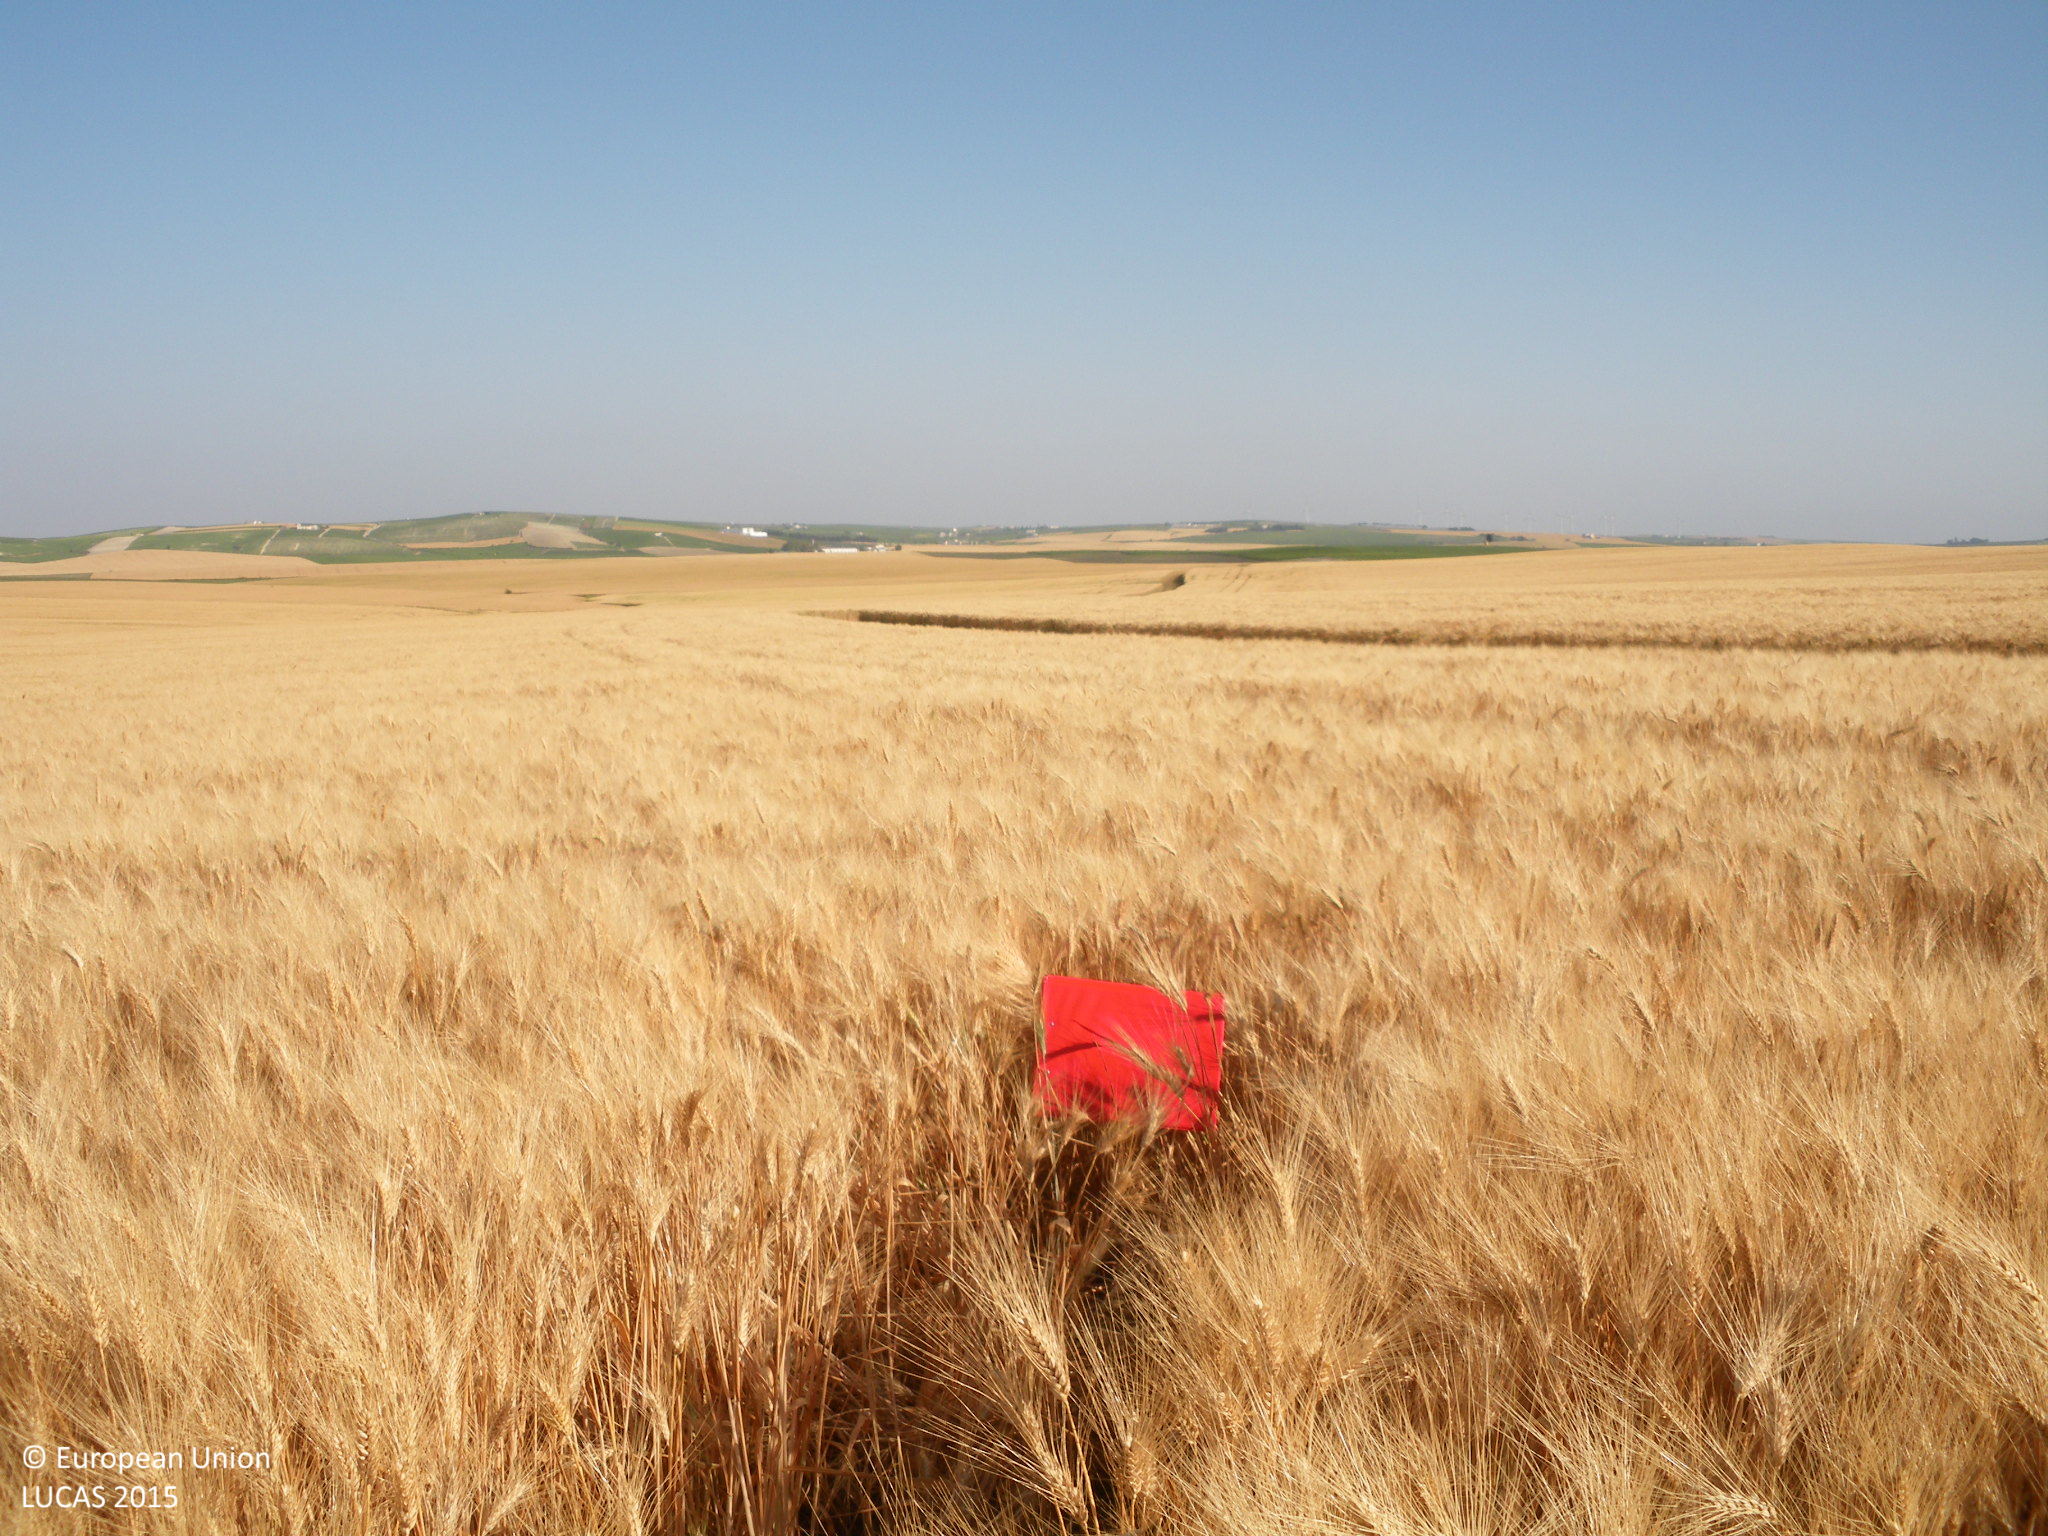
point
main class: Cropland
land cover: Durum wheat
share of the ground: > 75 %
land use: Agriculture (excluding fallow land and kitchen gardens)
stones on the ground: < 10 %
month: May
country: ES
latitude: 36.7683
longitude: -6.2263
